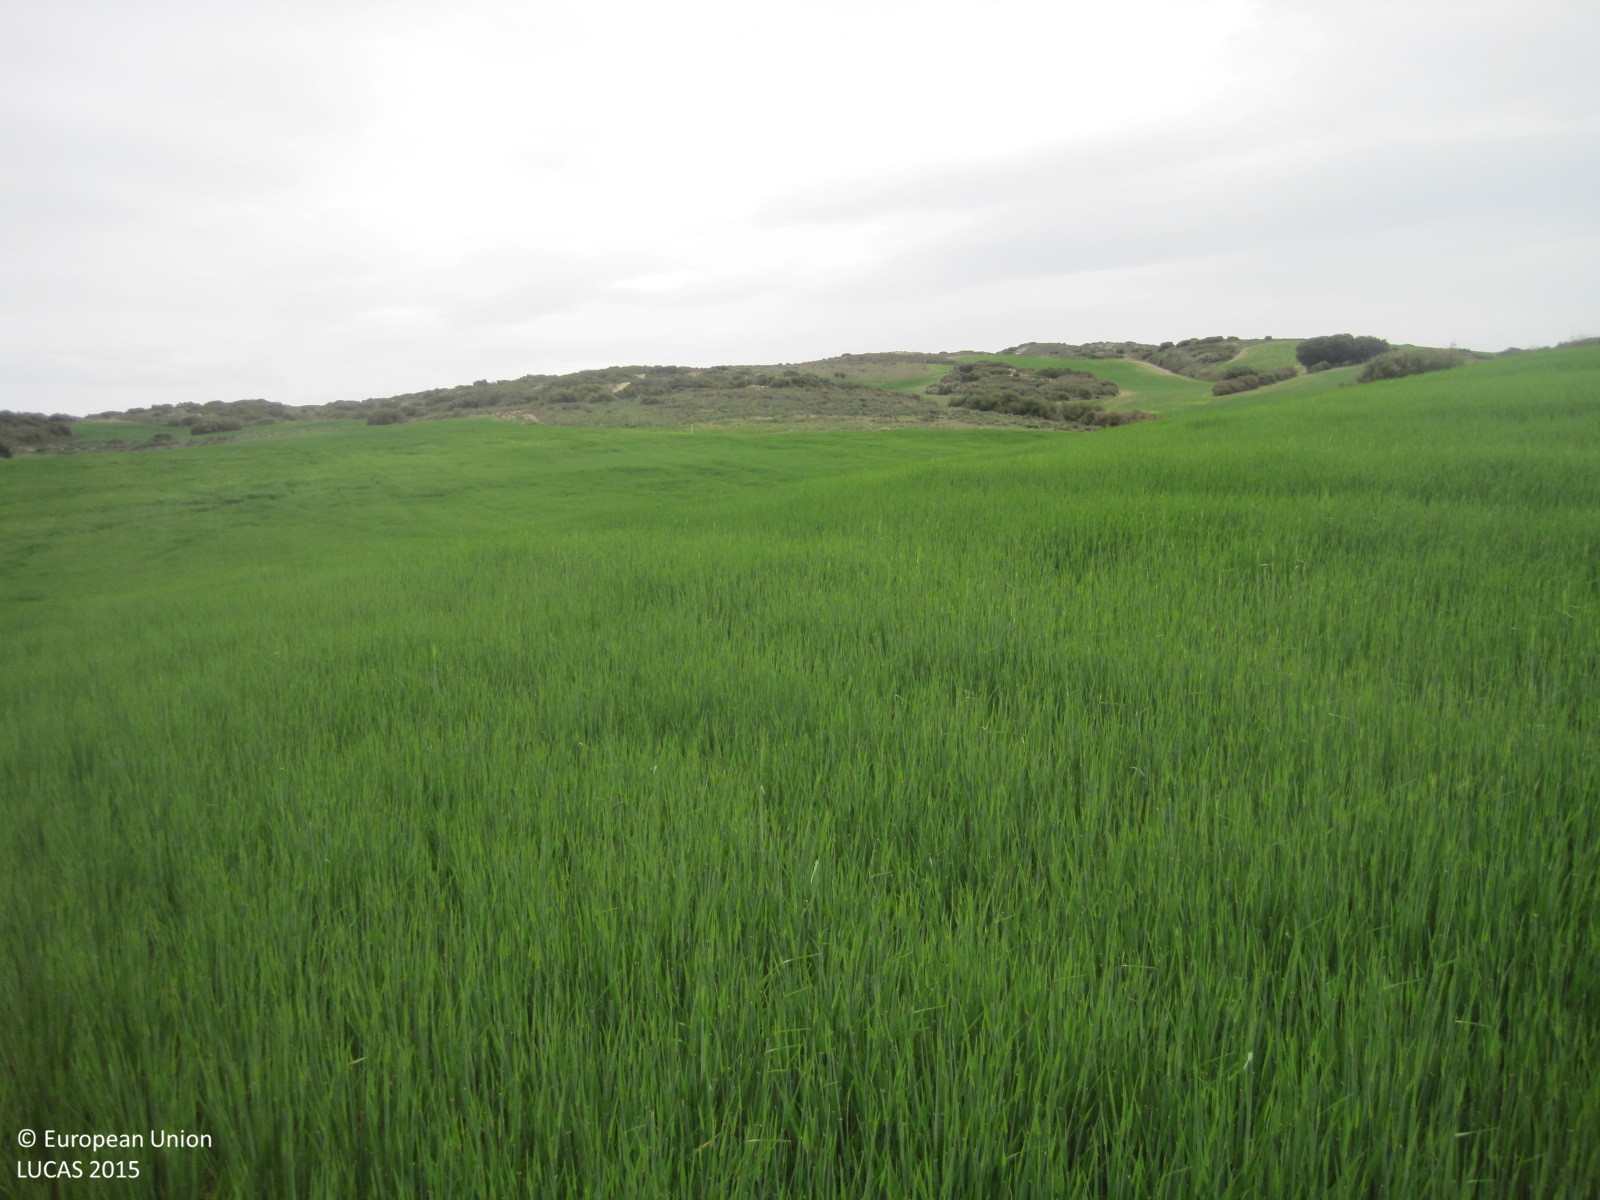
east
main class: Cropland
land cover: Barley
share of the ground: > 75 %
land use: Agriculture (excluding fallow land and kitchen gardens)
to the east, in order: Barley; Grassland without tree/shrub cover; Shrubland without tree cover; Tracks; Shrubland without tree cover
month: April
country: ES
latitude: 42.5597
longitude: -2.1369
